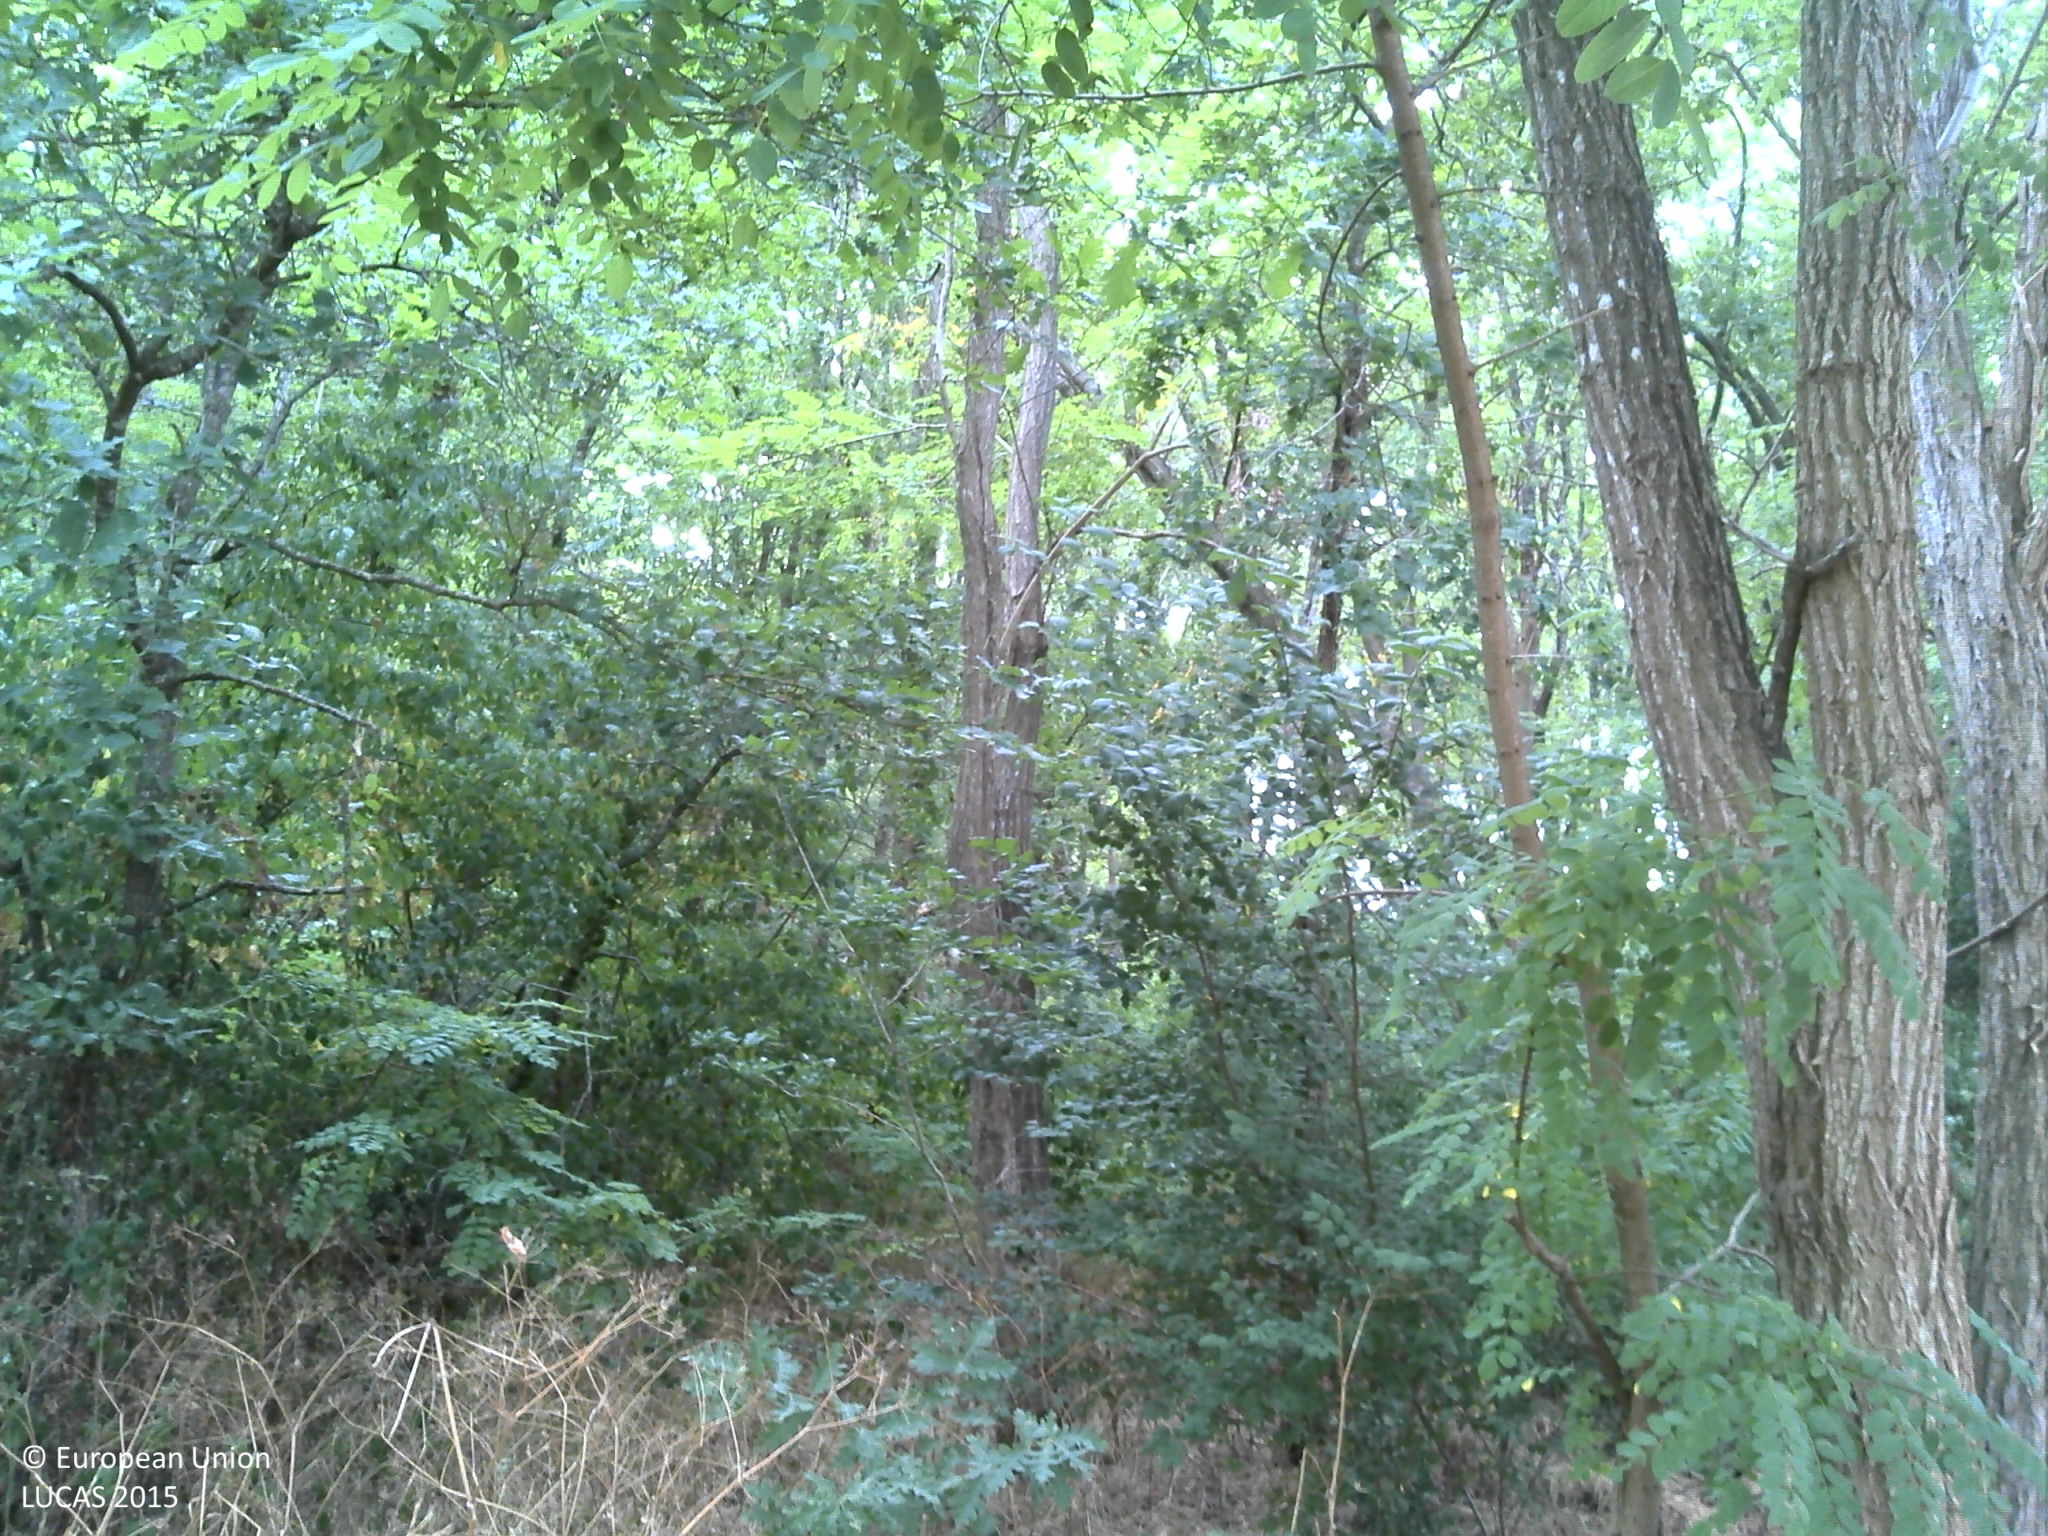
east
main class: Woodland
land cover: Broadleaved woodland
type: mesophytic deciduous forest
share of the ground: > 75 %
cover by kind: broadleaved forest trees 80 %, shrubs 10 %, herbaceous plants 5 %, lichens and mosses 5 %
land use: Semi-natural and natural areas not in use
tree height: > 5 m
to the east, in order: Grass margins; Broadleaved woodland; Tracks; Broadleaved woodland
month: July
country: FR
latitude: 44.6427
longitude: -0.5954
